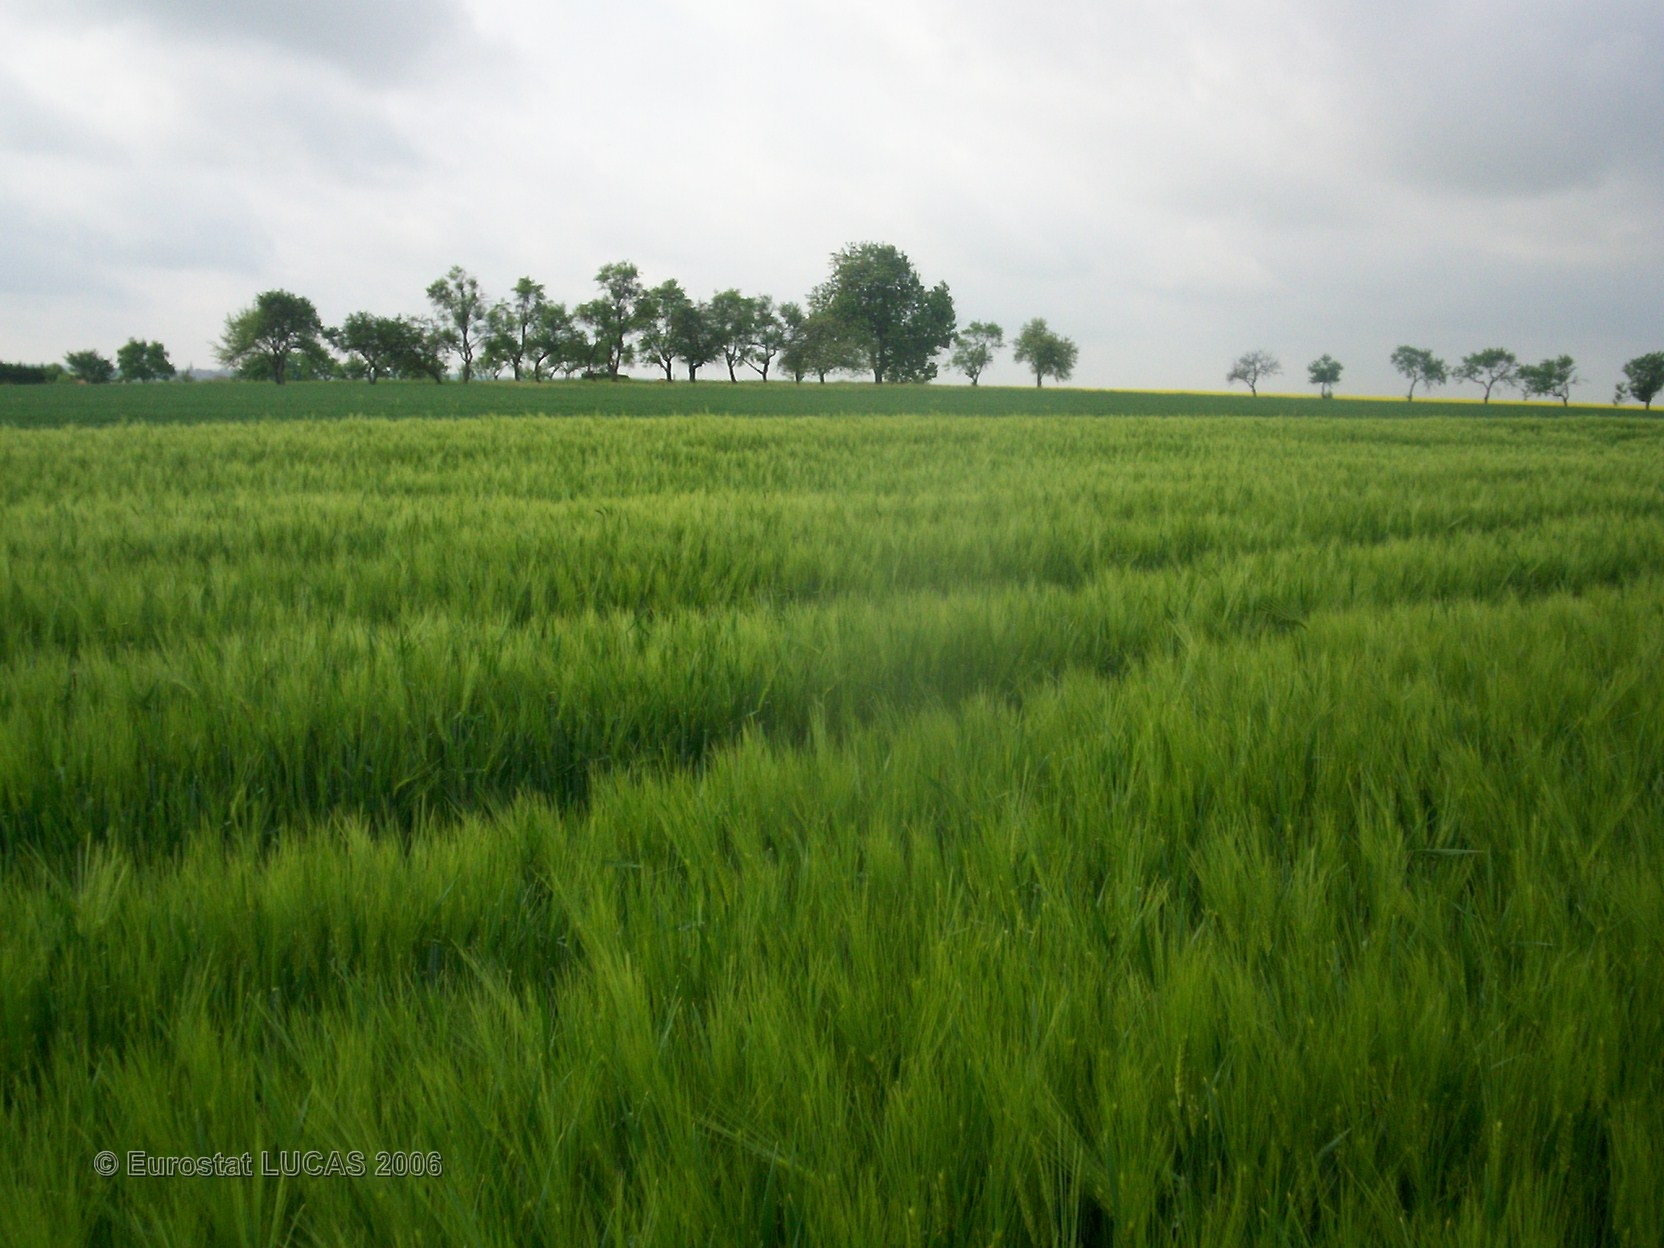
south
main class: Cropland
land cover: Barley
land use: Agriculture (excluding fallow land and kitchen gardens)
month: May
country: FR
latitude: 49.1012
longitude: 5.8766
